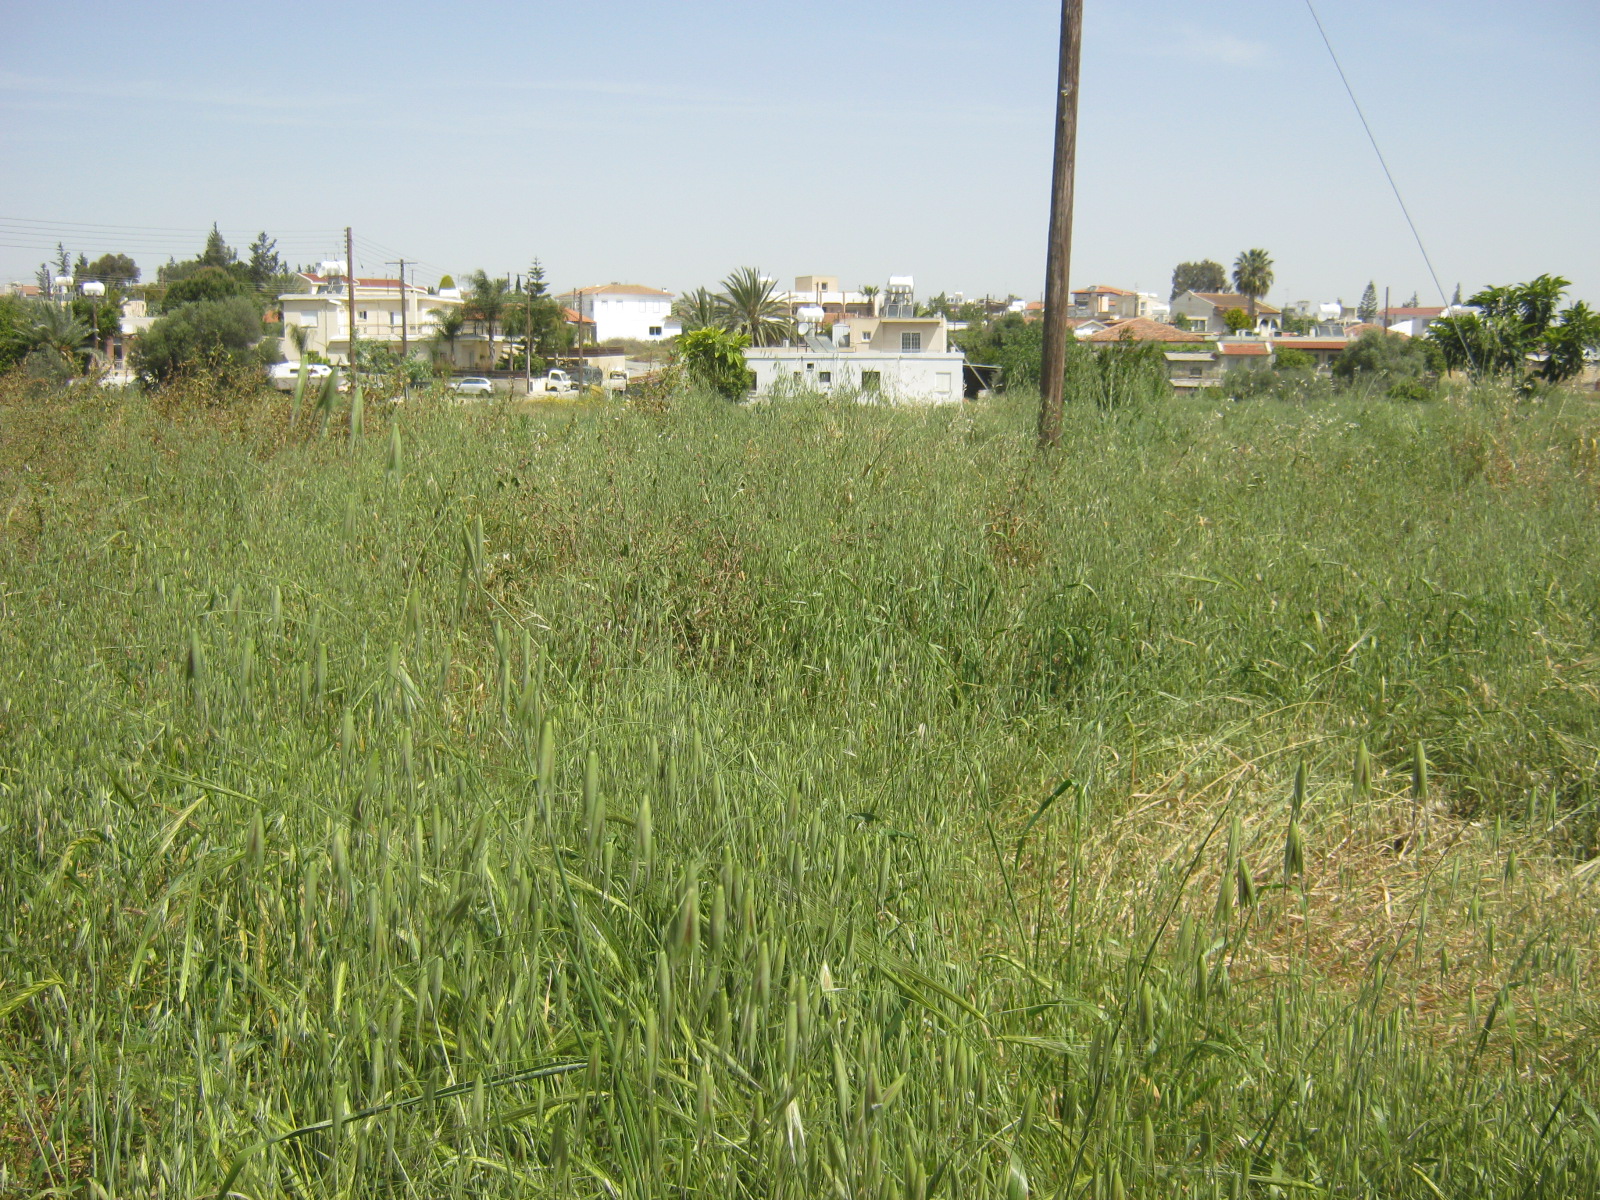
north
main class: Grassland
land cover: Spontaneously vegetated surfaces
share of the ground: > 75 %
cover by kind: herbaceous plants 100 %
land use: Residential
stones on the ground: < 10 %
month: April
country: CY
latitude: 35.0508
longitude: 33.2415
